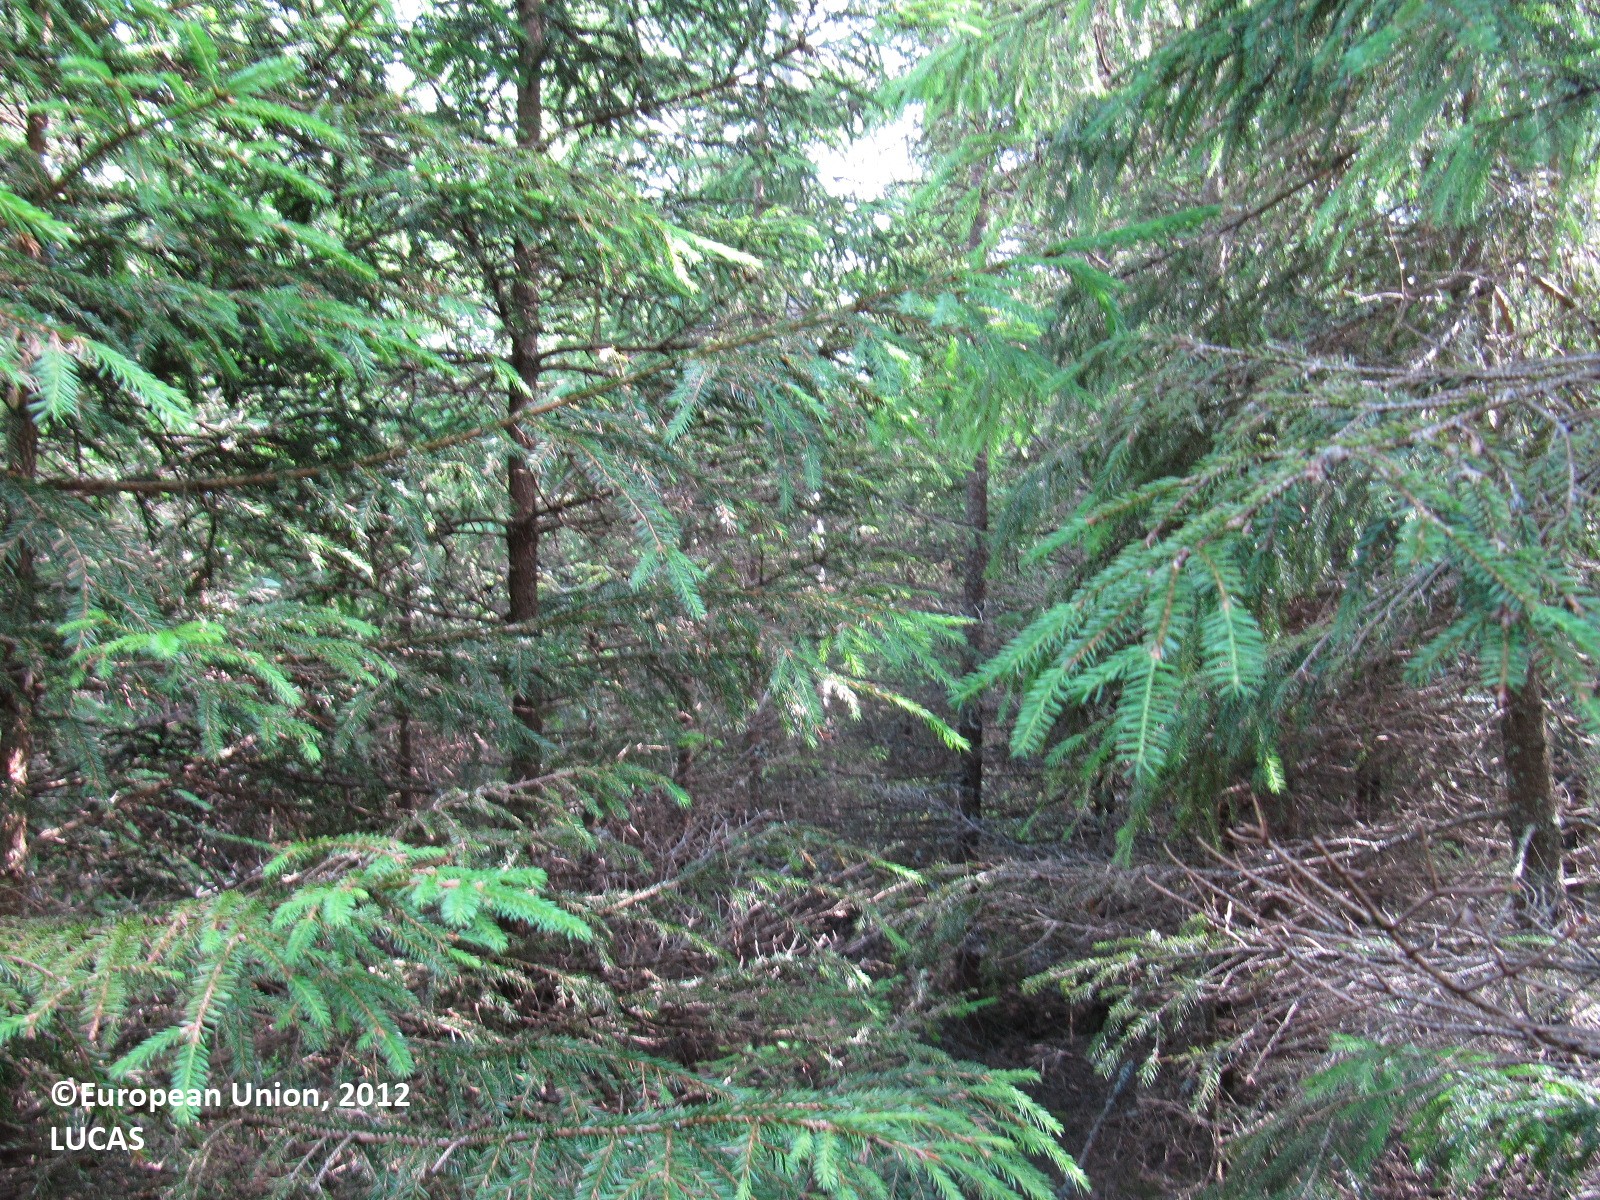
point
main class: Woodland
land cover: Spruce dominated mixed woodland
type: boreal forest
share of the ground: > 75 %
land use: Forestry
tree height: > 5 m
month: July
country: FI
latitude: 60.8569
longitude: 24.1417
